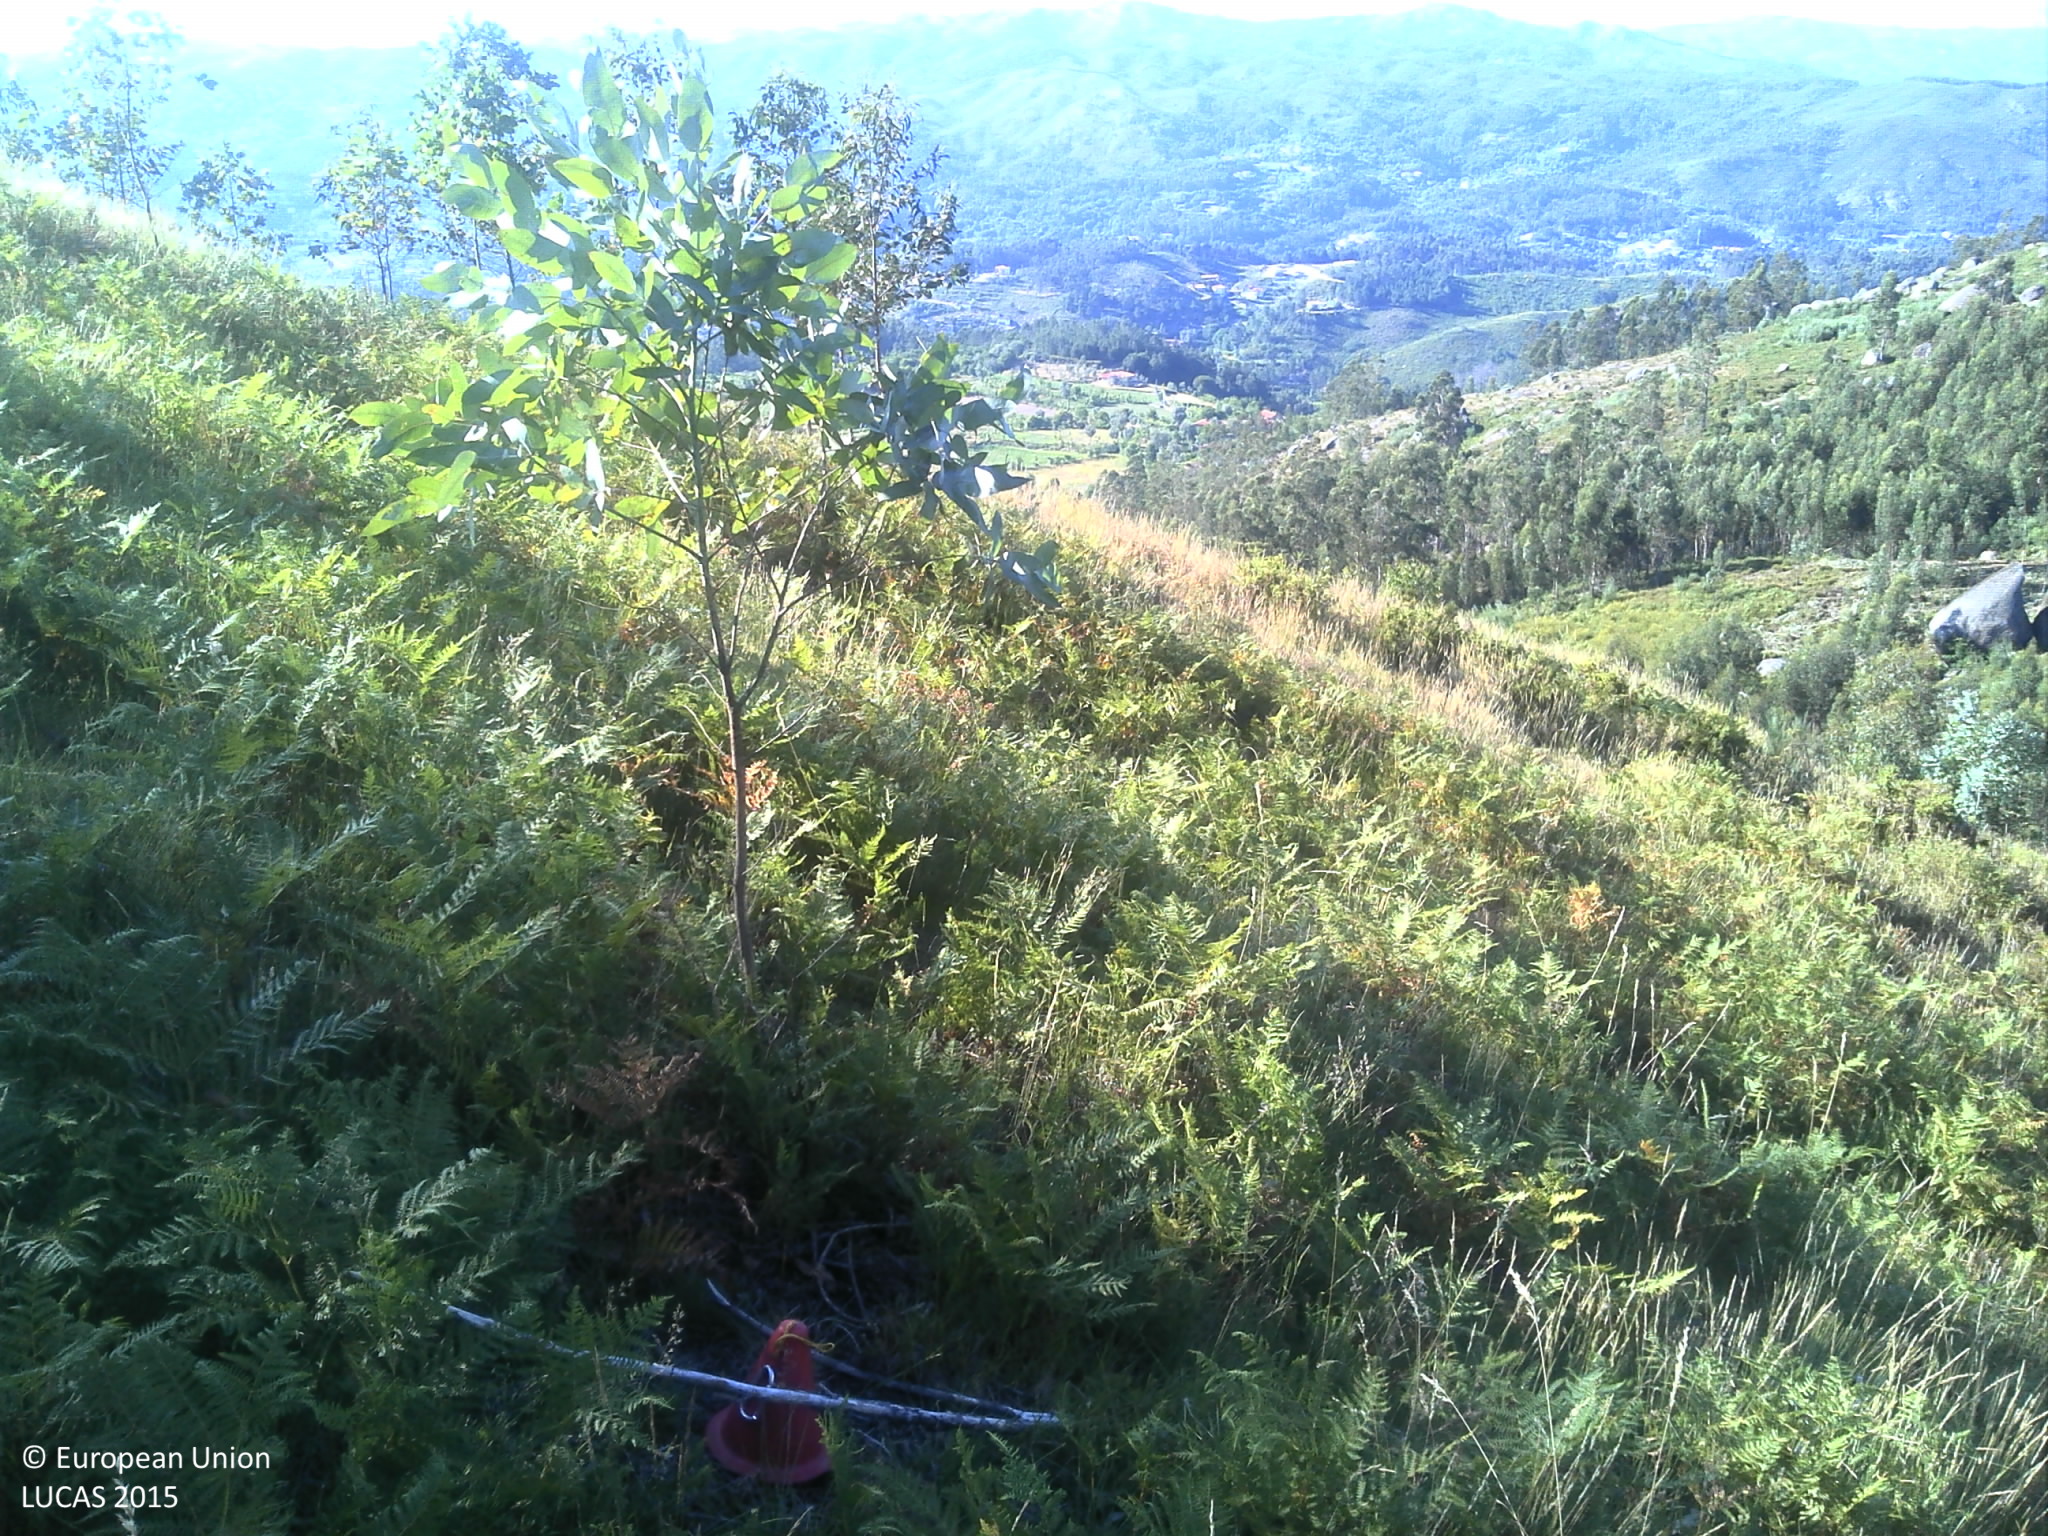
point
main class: Shrubland
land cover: Shrubland with sparse tree cover
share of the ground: > 75 %
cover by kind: shrubs 85 %, broadleaved forest trees 5 %, herbaceous plants 5 %, unconsolidated bare surface 5 %
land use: Agriculture (excluding fallow land and kitchen gardens)
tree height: < 5 m
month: June
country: PT
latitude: 41.5491
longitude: -8.1650
